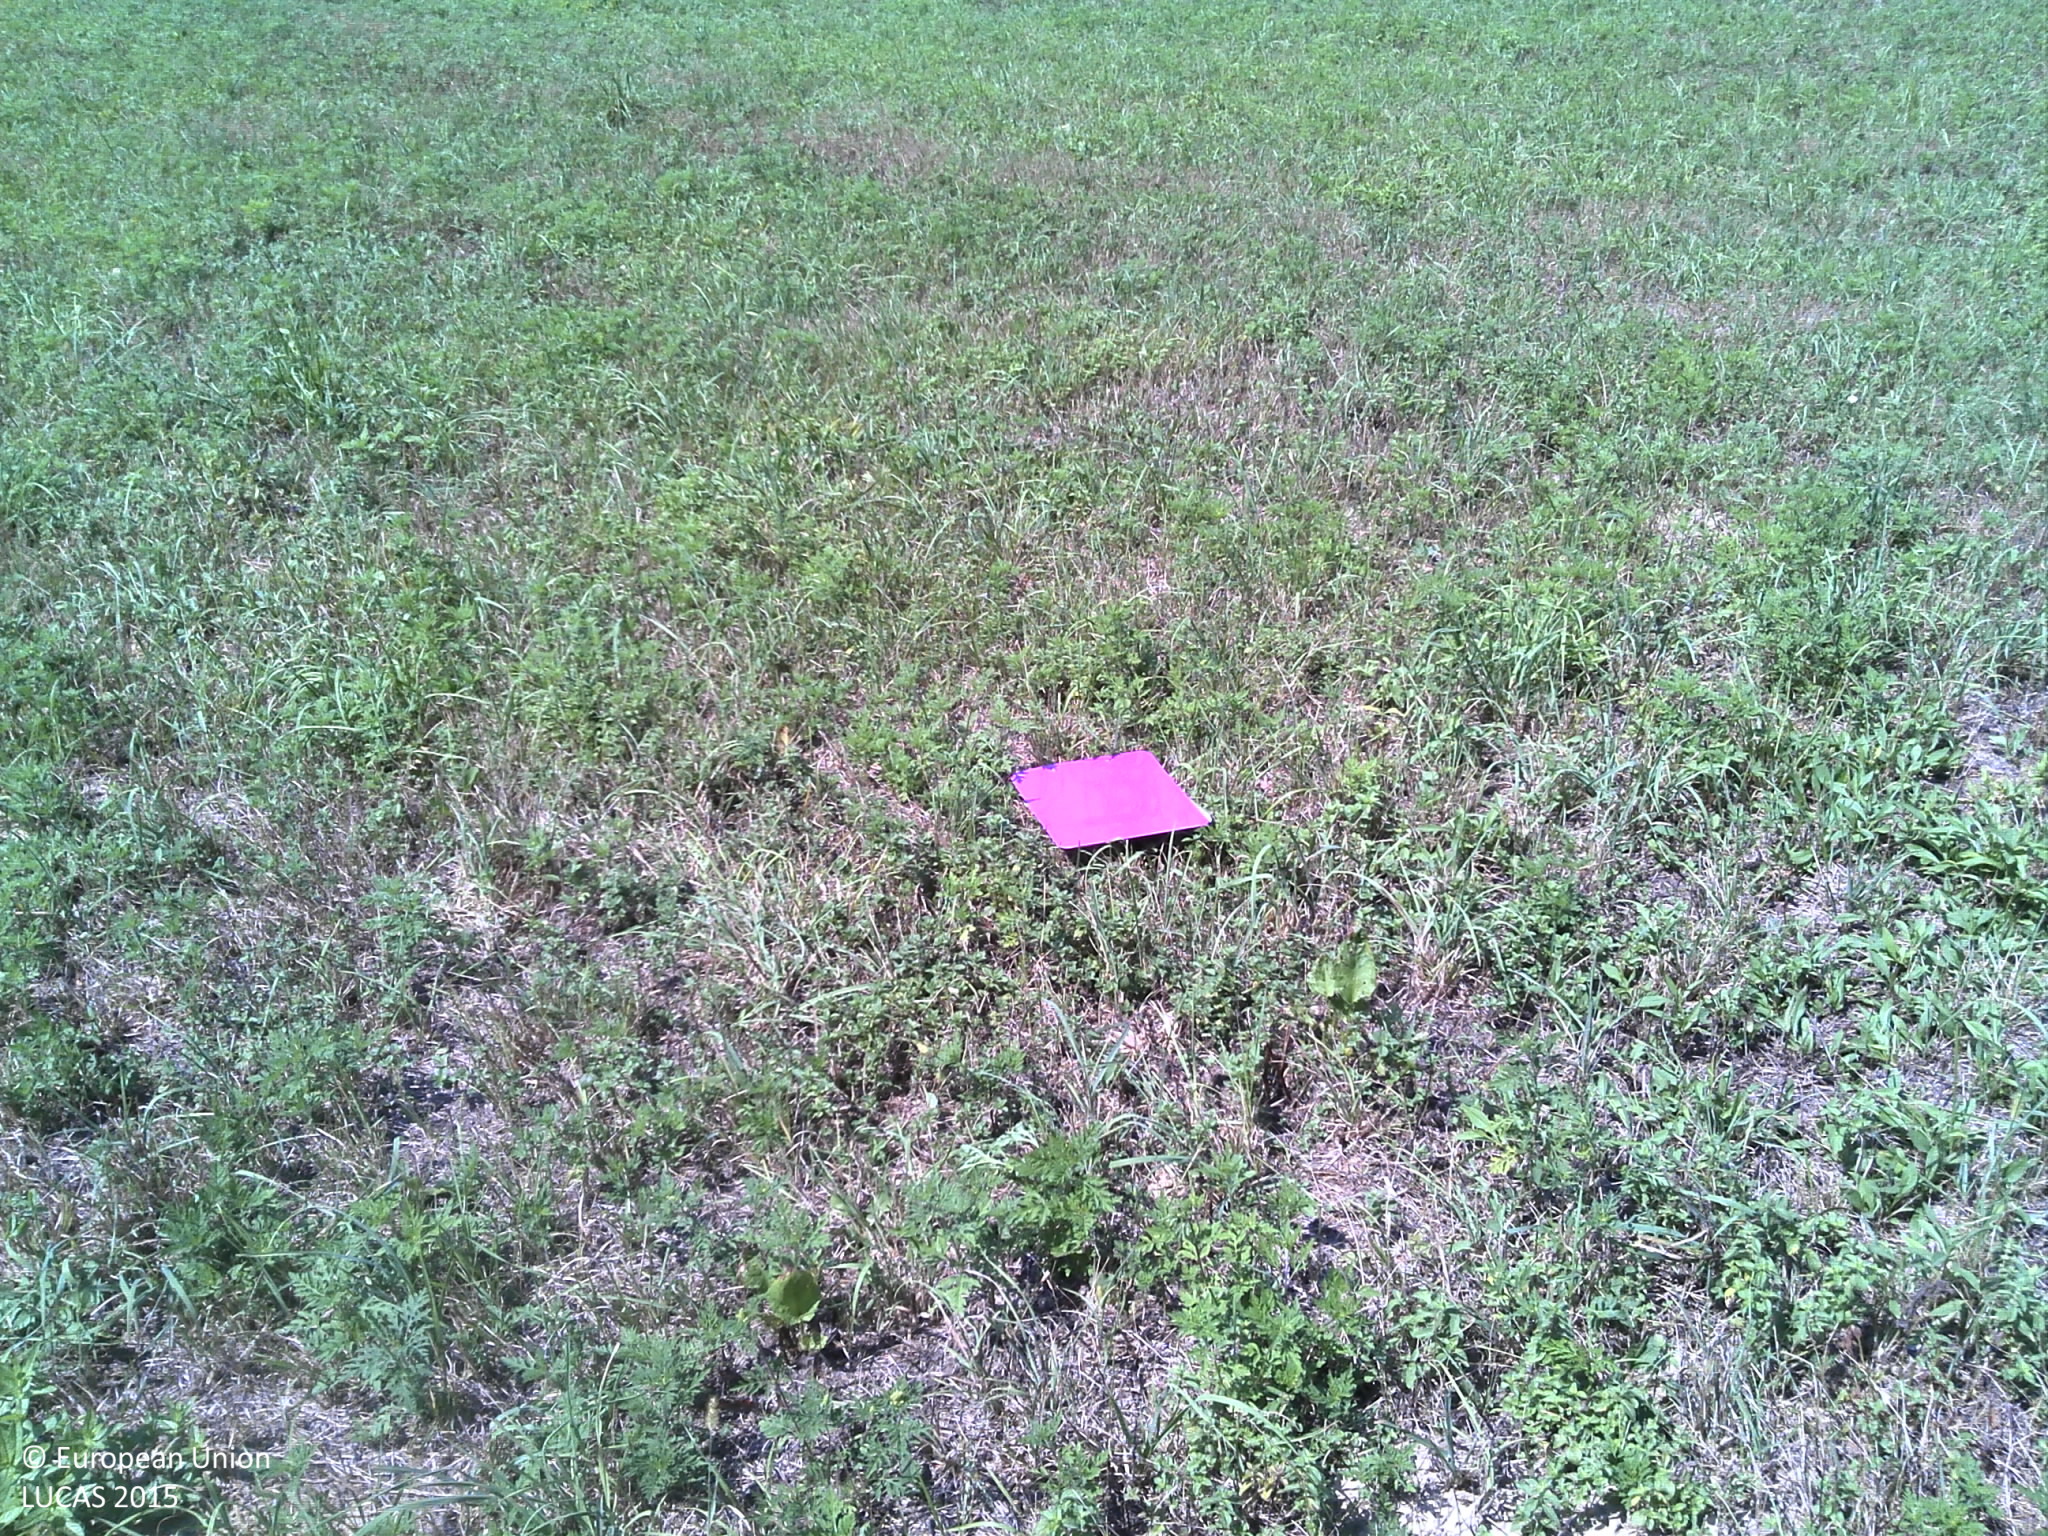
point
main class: Grassland
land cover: Spontaneously vegetated surfaces
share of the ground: > 75 %
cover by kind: herbaceous plants 100 %
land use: Semi-natural and natural areas not in use
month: August
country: HR
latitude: 46.0991
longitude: 16.7921
